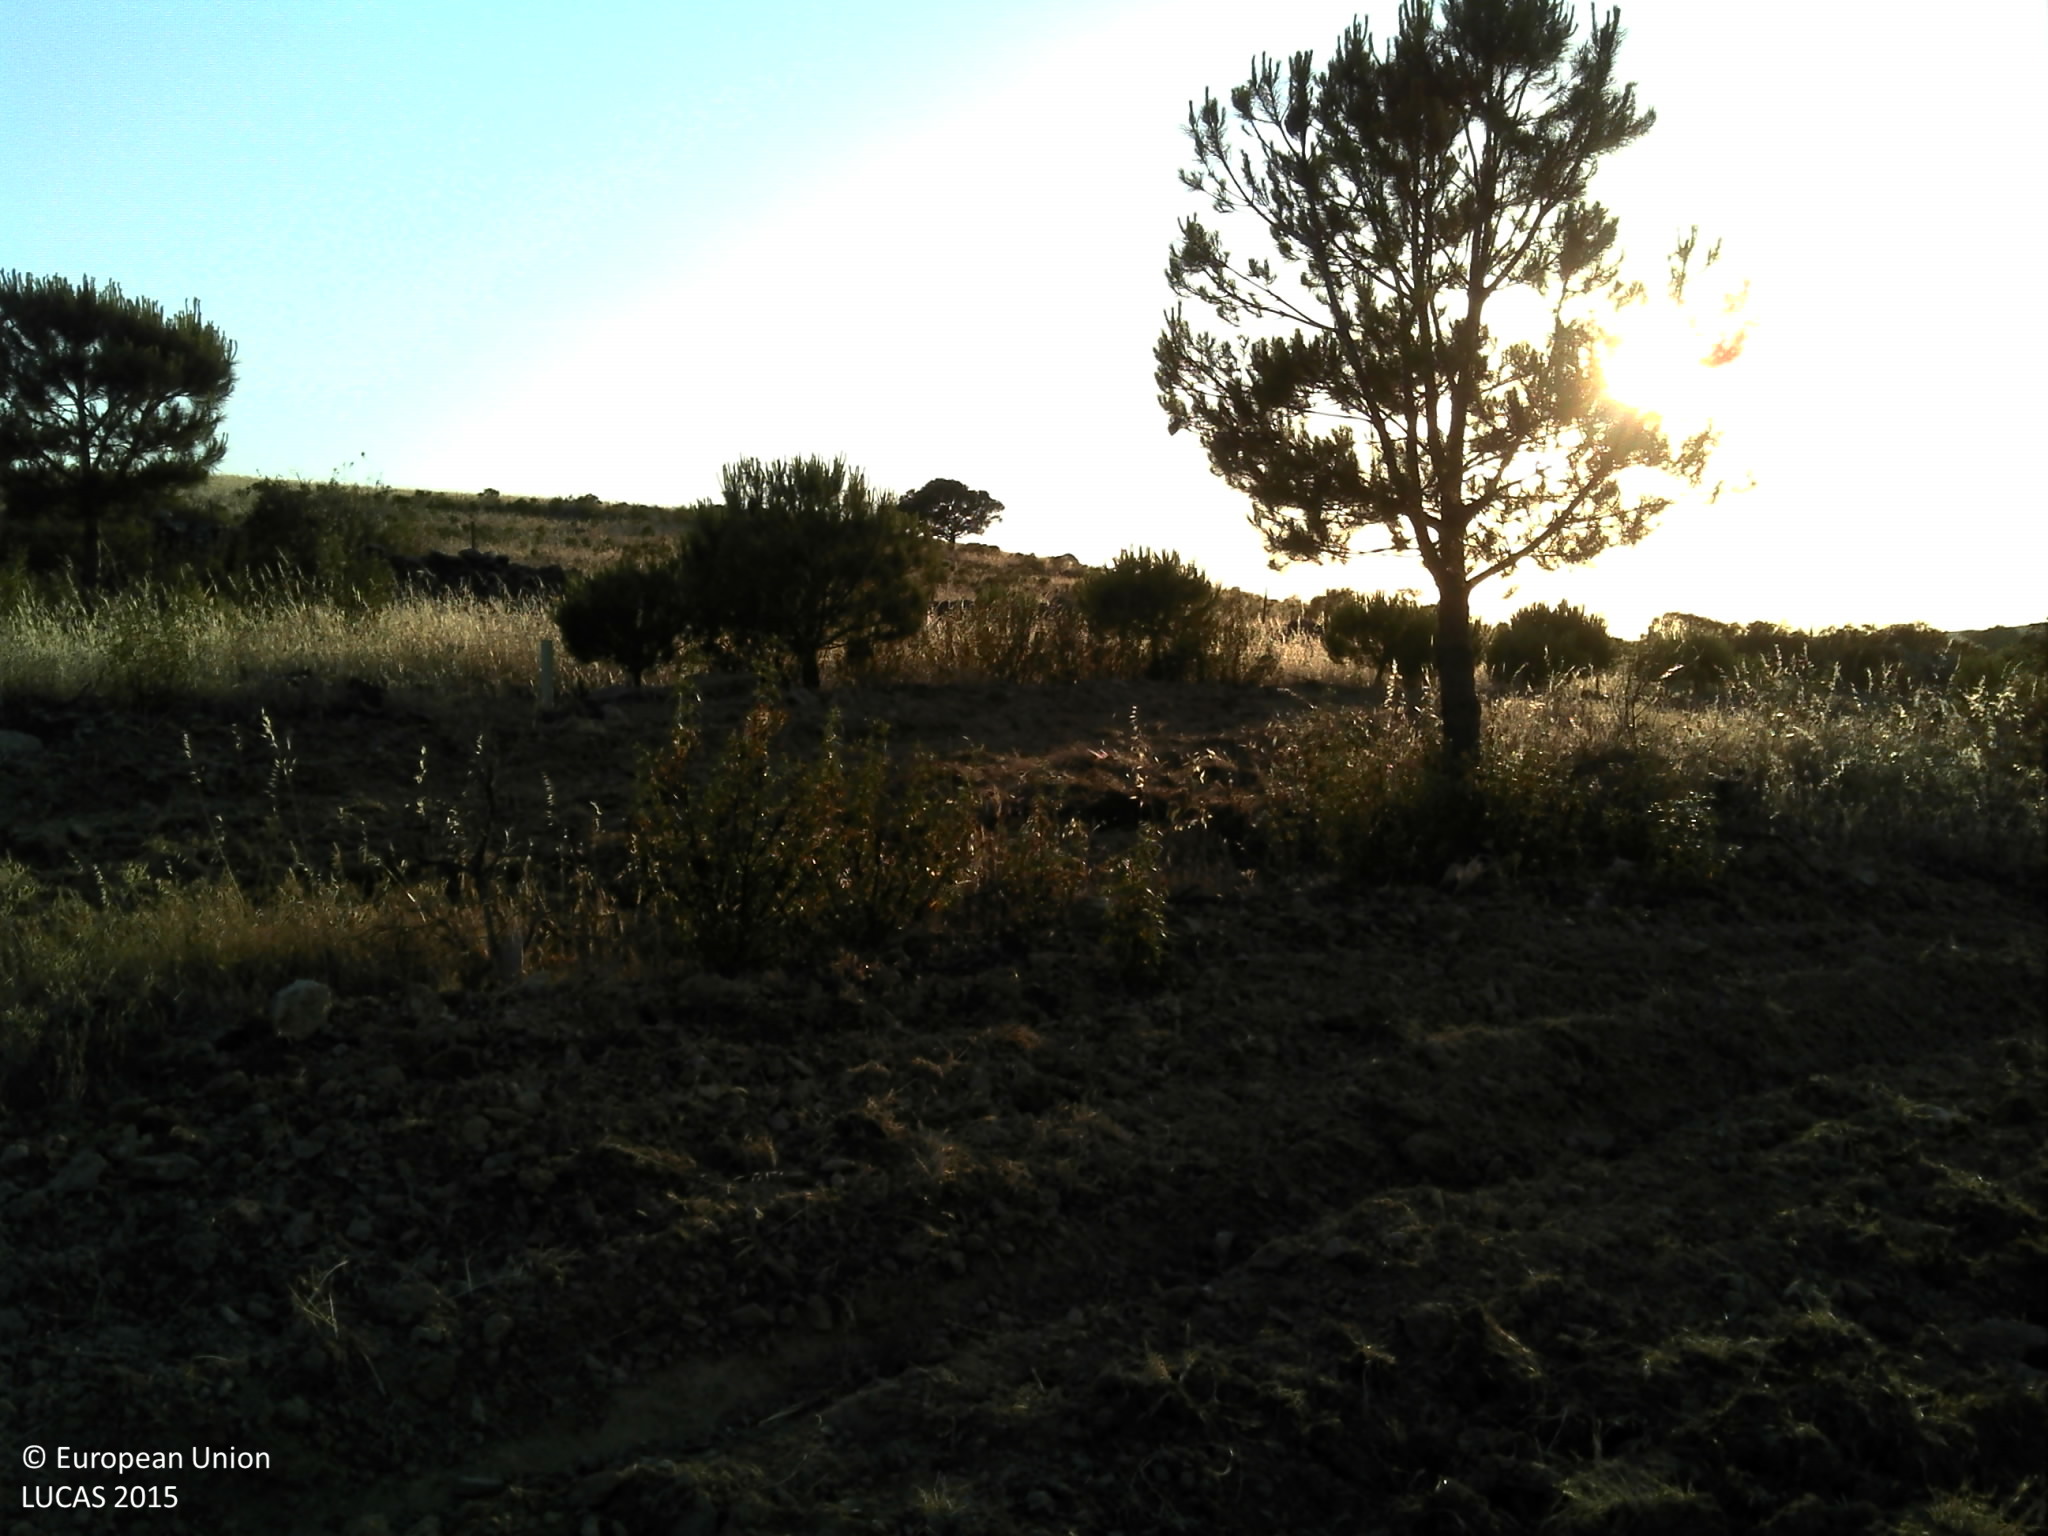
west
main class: Woodland
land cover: Pine dominated coniferous woodland
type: coniferous forest of the mediterranean region
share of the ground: 10 - 25 %
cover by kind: consolidated bare surface 50 %, coniferous forest trees 25 %, herbaceous plants 25 %
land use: Forestry
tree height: < 5 m
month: May
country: PT
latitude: 37.5039
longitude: -7.7638
